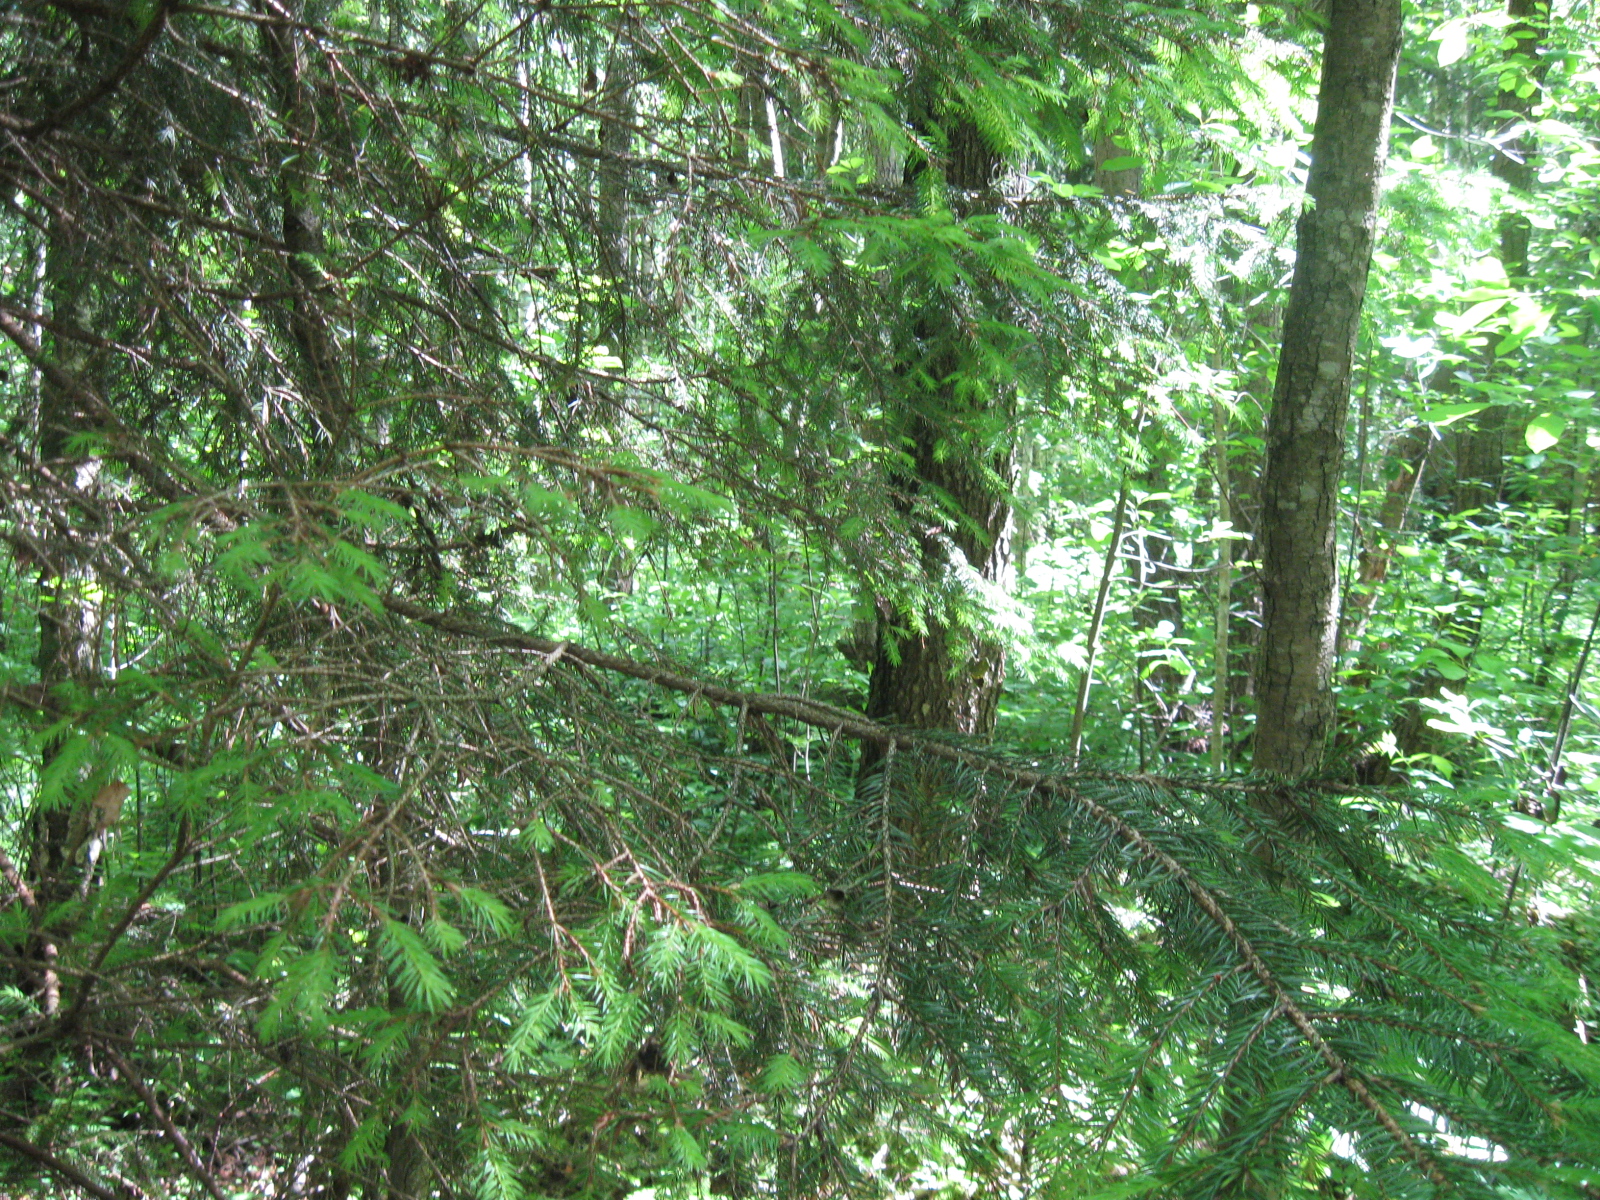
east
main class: Woodland
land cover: Spruce dominated mixed woodland
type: hemiboreal forest and nemoral coniferous forest and mixed broadleaved-coniferous forest
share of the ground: > 75 %
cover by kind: broadleaved forest trees 70 %, coniferous forest trees 30 %
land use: Forestry
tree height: > 5 m
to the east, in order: Spruce dominated mixed woodland; Broadleaved woodland; Other mixed woodland; Pine dominated mixed woodland
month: June
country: LT
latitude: 53.9631
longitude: 24.2275
